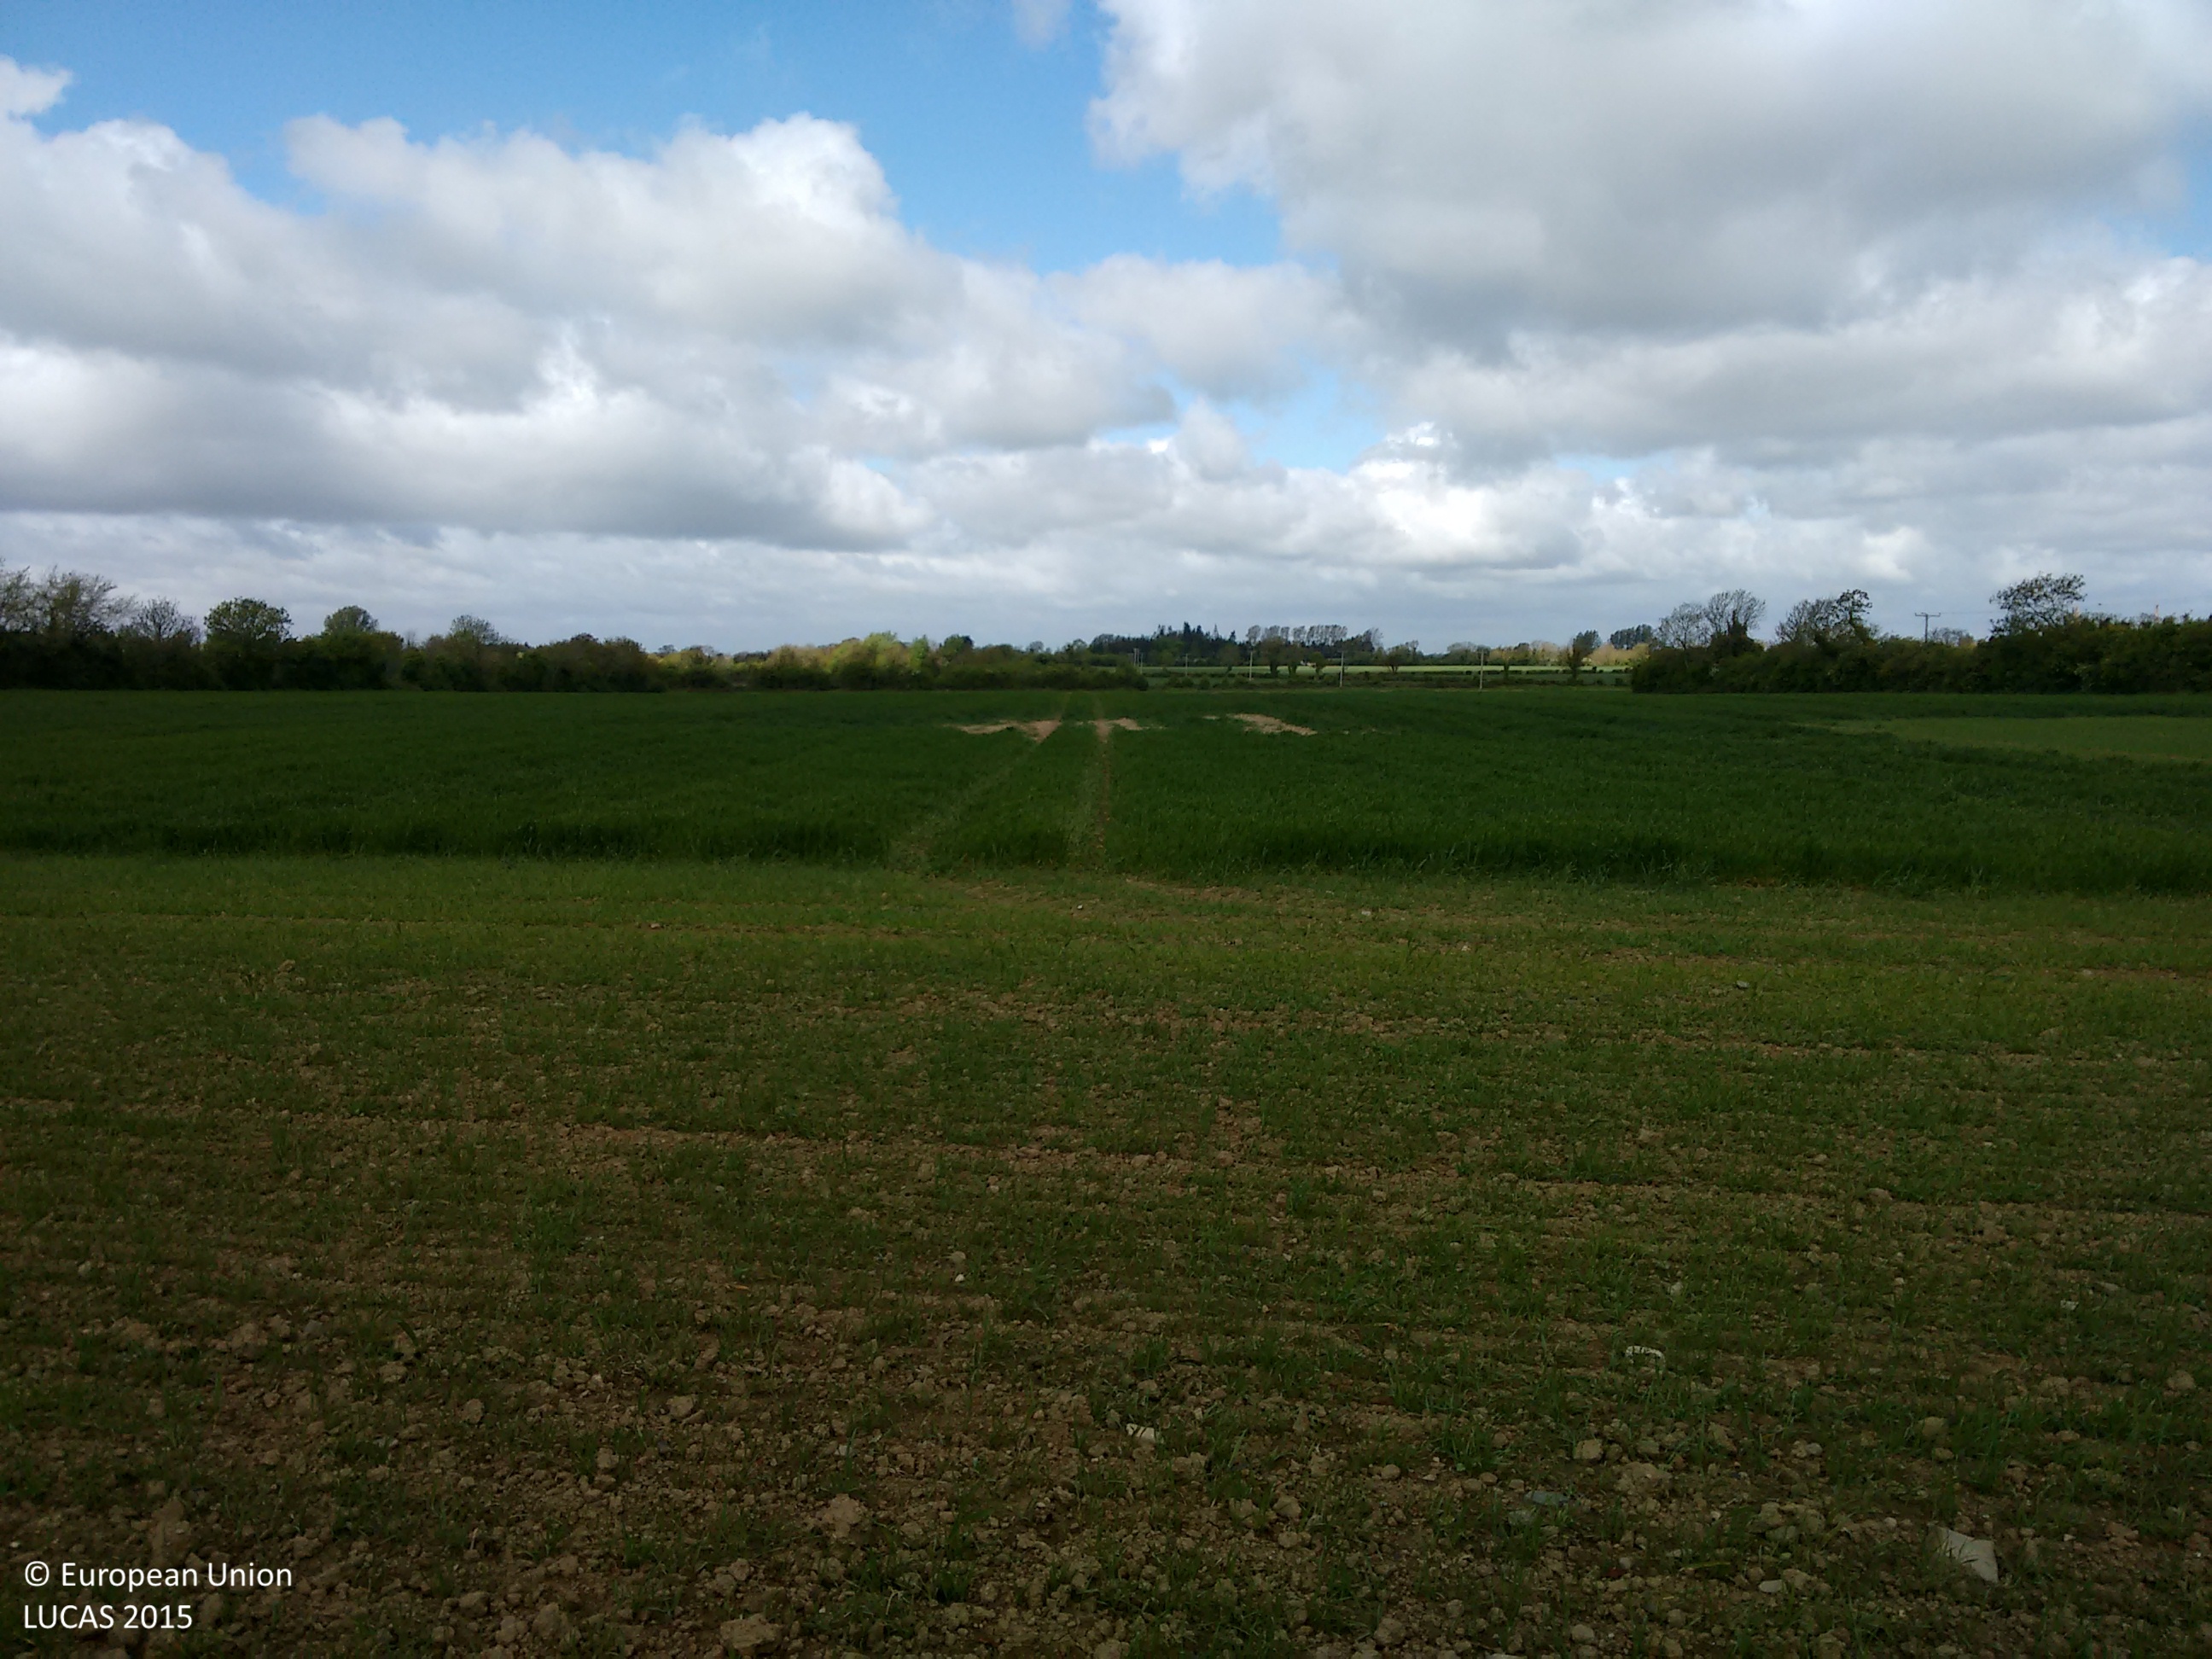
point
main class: Cropland
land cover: Barley
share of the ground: 50 - 75 %
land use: Agriculture (excluding fallow land and kitchen gardens)
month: May
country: IE
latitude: 53.3061
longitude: -6.4996
